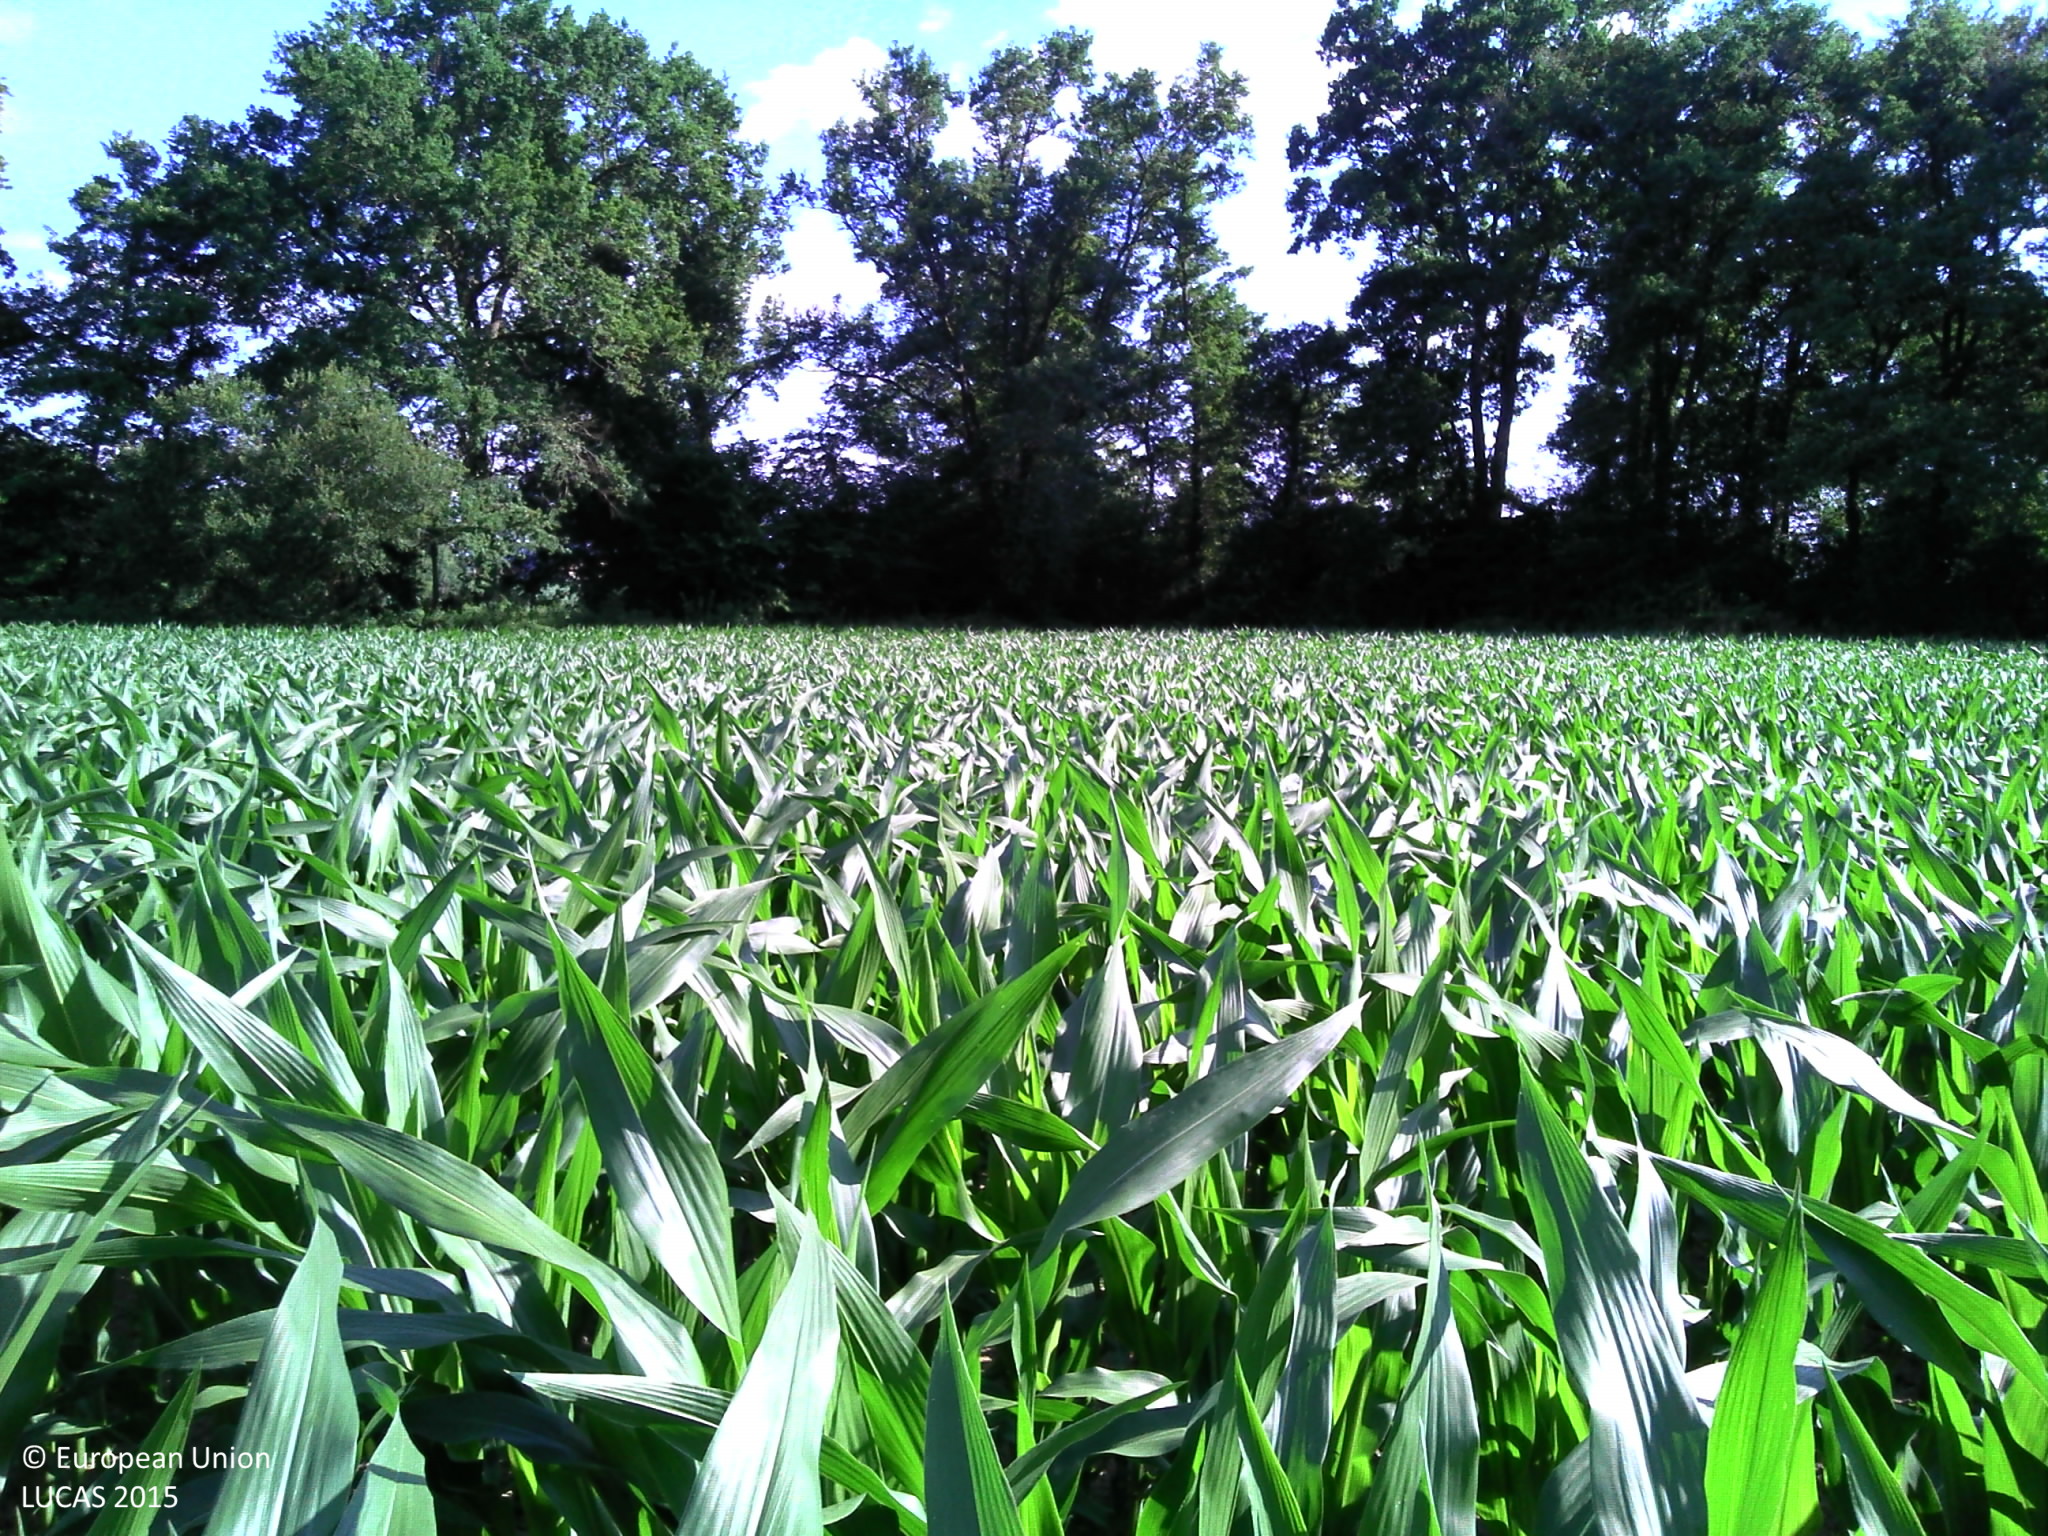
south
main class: Cropland
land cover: Maize
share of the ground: > 75 %
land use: Agriculture (excluding fallow land and kitchen gardens)
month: June
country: FR
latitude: 43.6031
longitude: -0.4531
